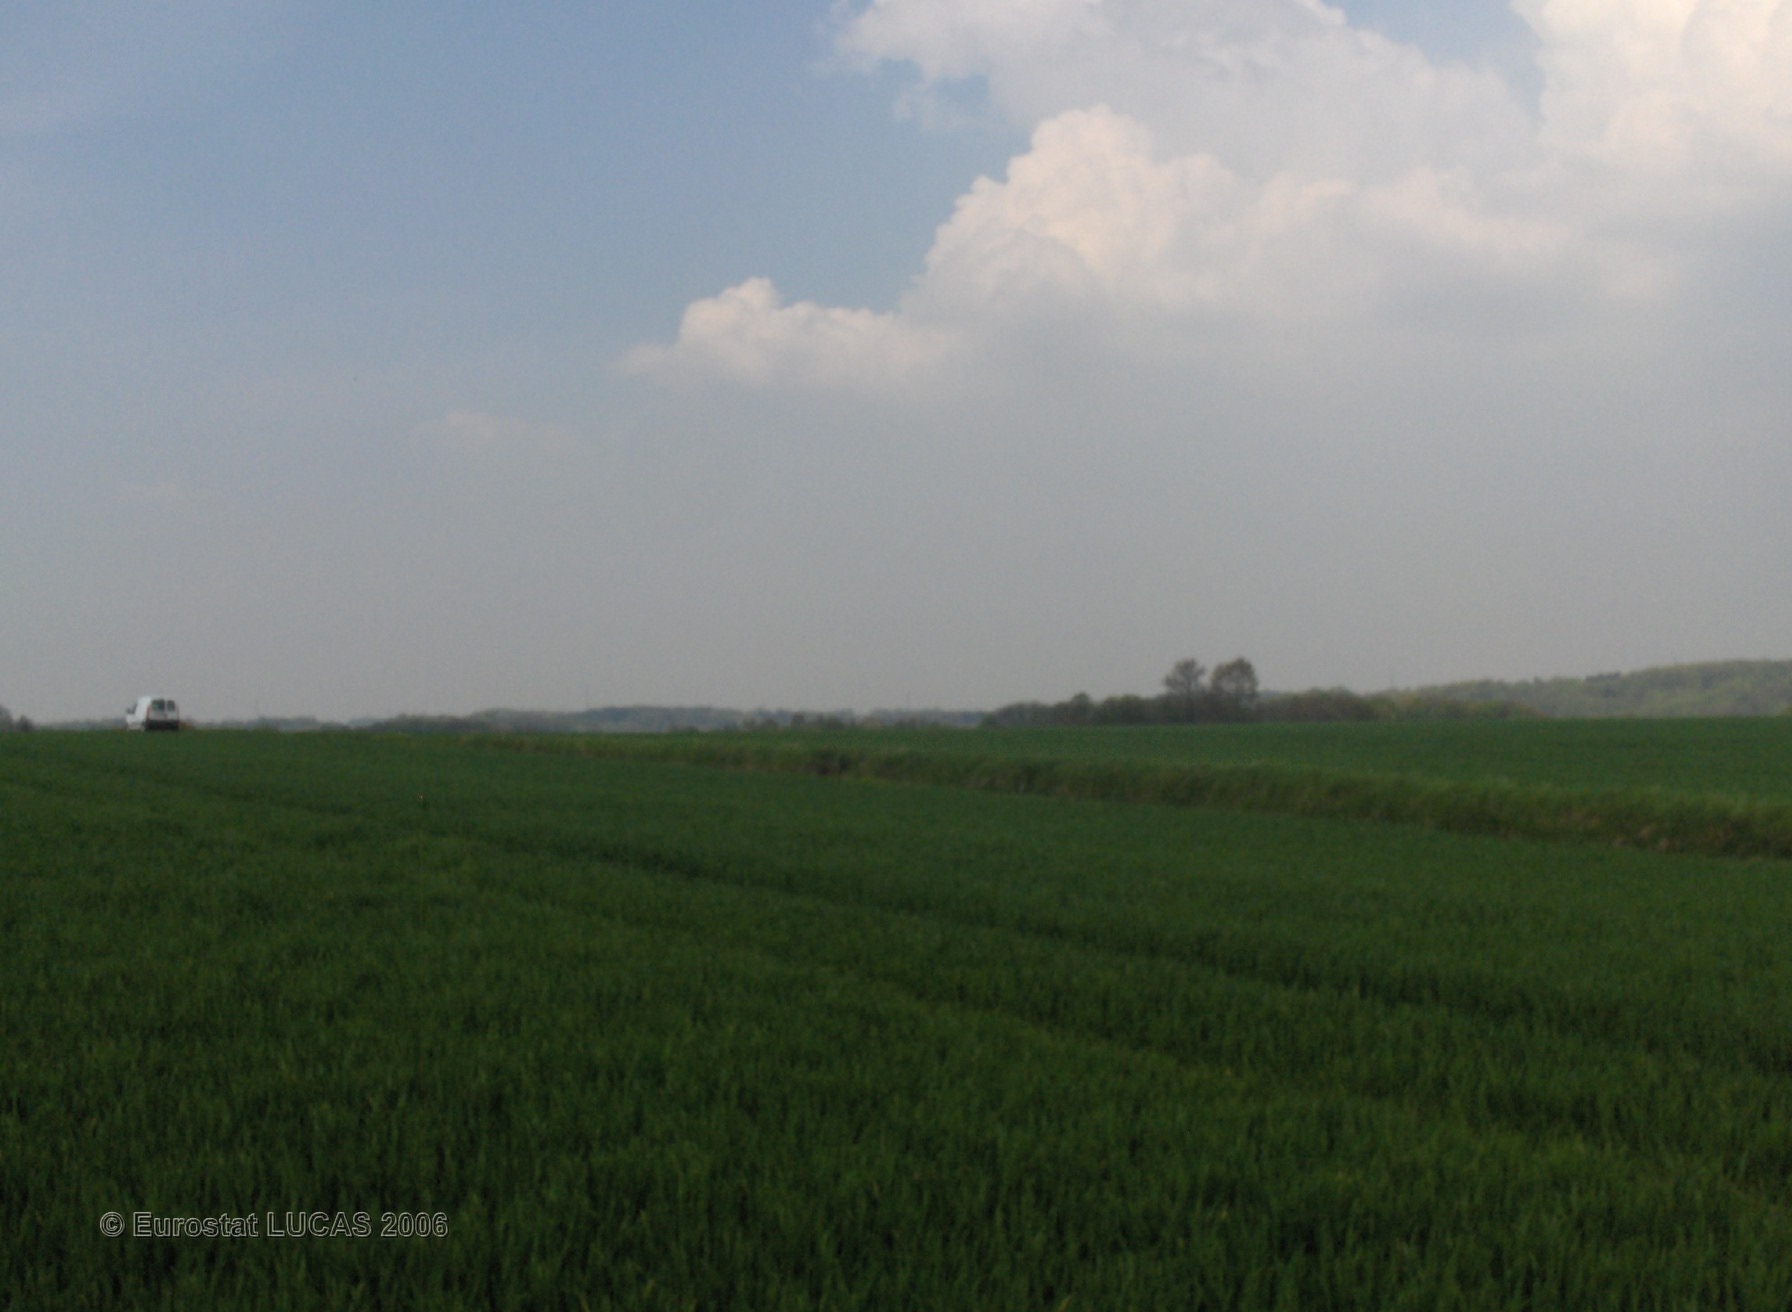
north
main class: Cropland
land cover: Common wheat
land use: Agriculture (excluding fallow land and kitchen gardens)
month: May
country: BE
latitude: 50.6295
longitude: 4.5248
